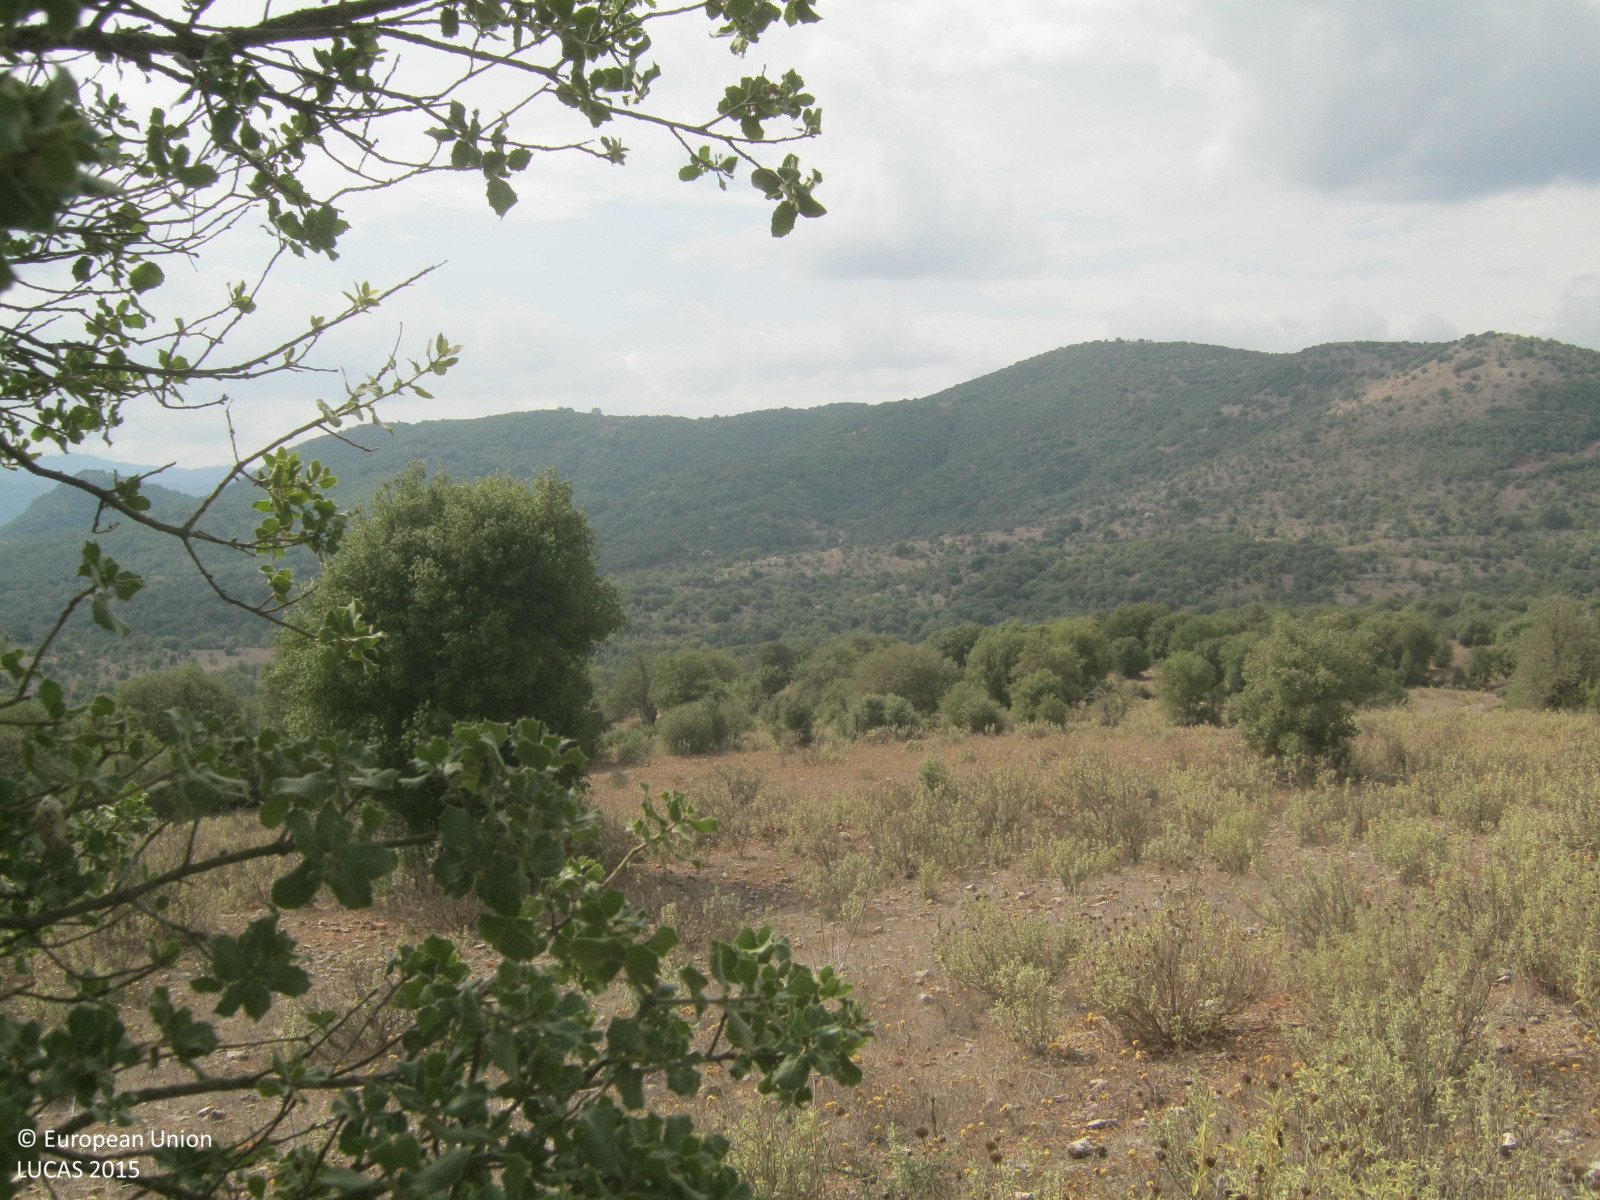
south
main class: Grassland
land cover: Grassland with sparse tree/shrub cover
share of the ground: 50 - 75 %
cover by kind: herbaceous plants 50 %, unconsolidated bare surface 35 %, shrubs 10 %, broadleaved forest trees 5 %
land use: Agriculture (excluding fallow land and kitchen gardens)
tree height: < 5 m
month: September
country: GR
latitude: 37.8370
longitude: 22.0657
